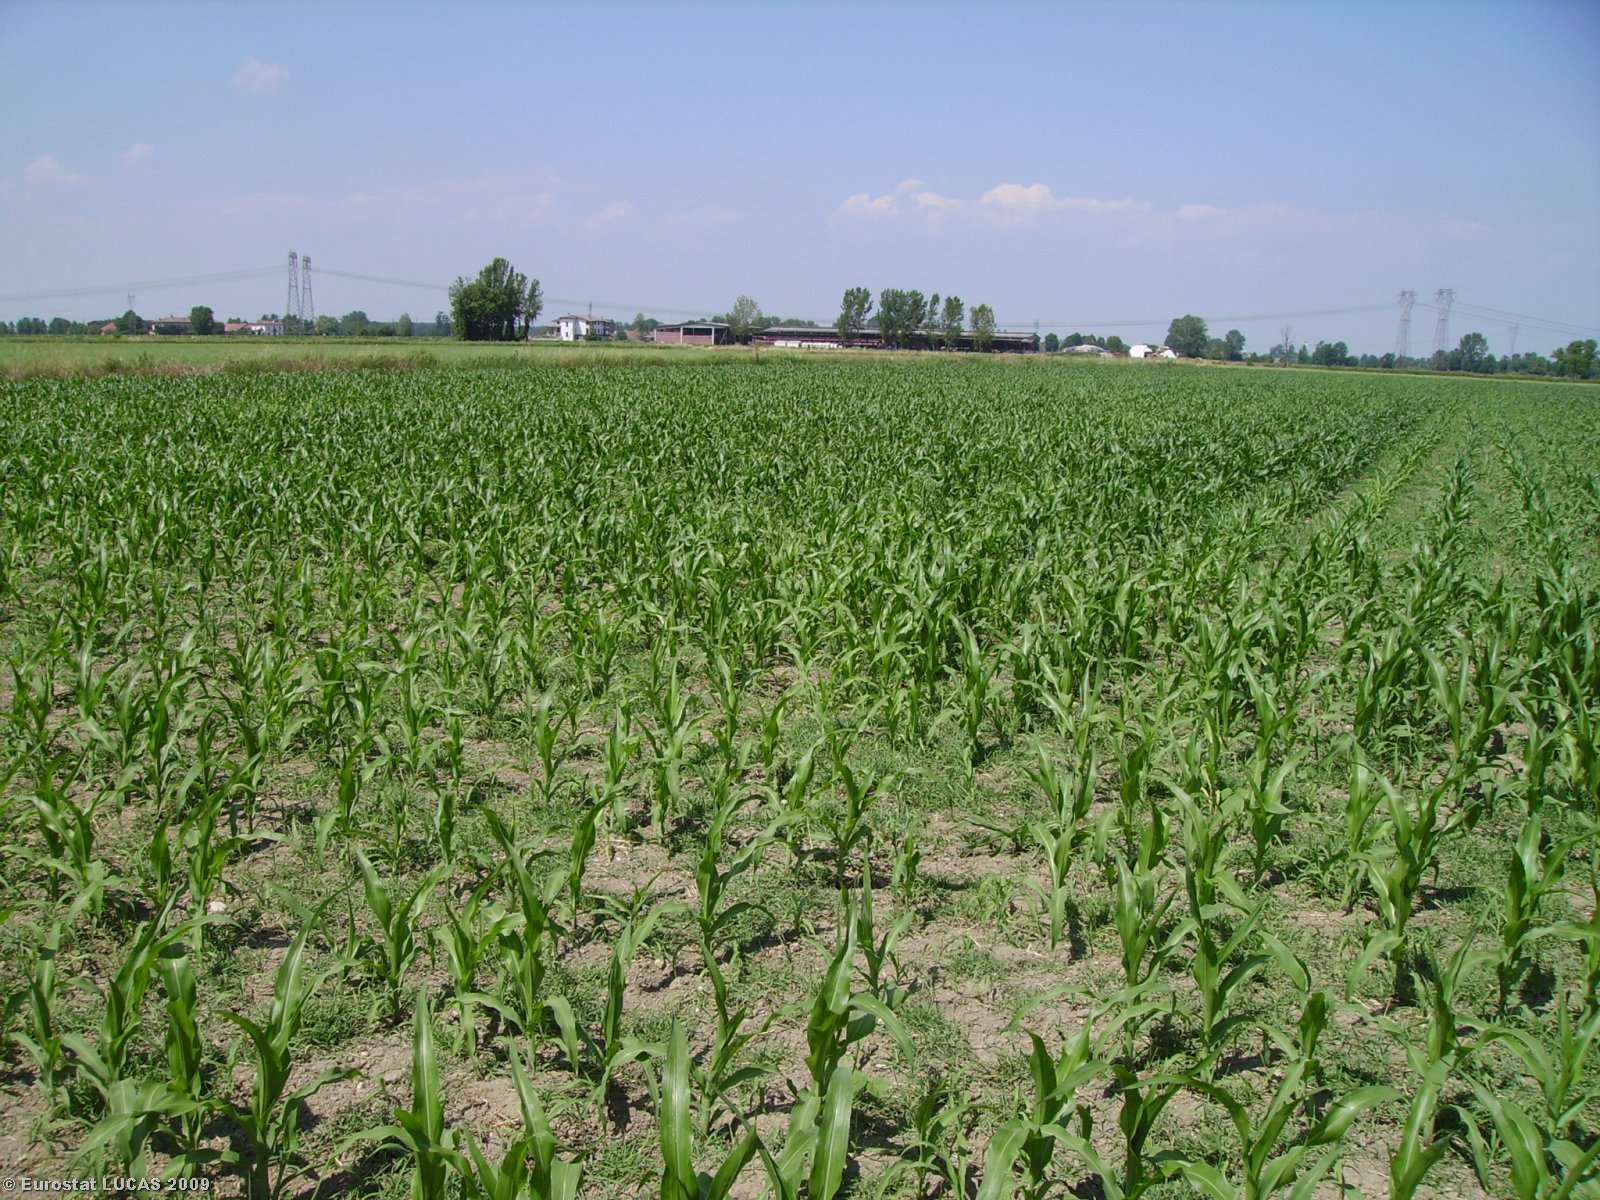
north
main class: Cropland
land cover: Maize
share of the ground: 10 - 25 %
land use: Agriculture (excluding fallow land and kitchen gardens)
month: June
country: IT
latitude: 45.3411
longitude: 9.5287
